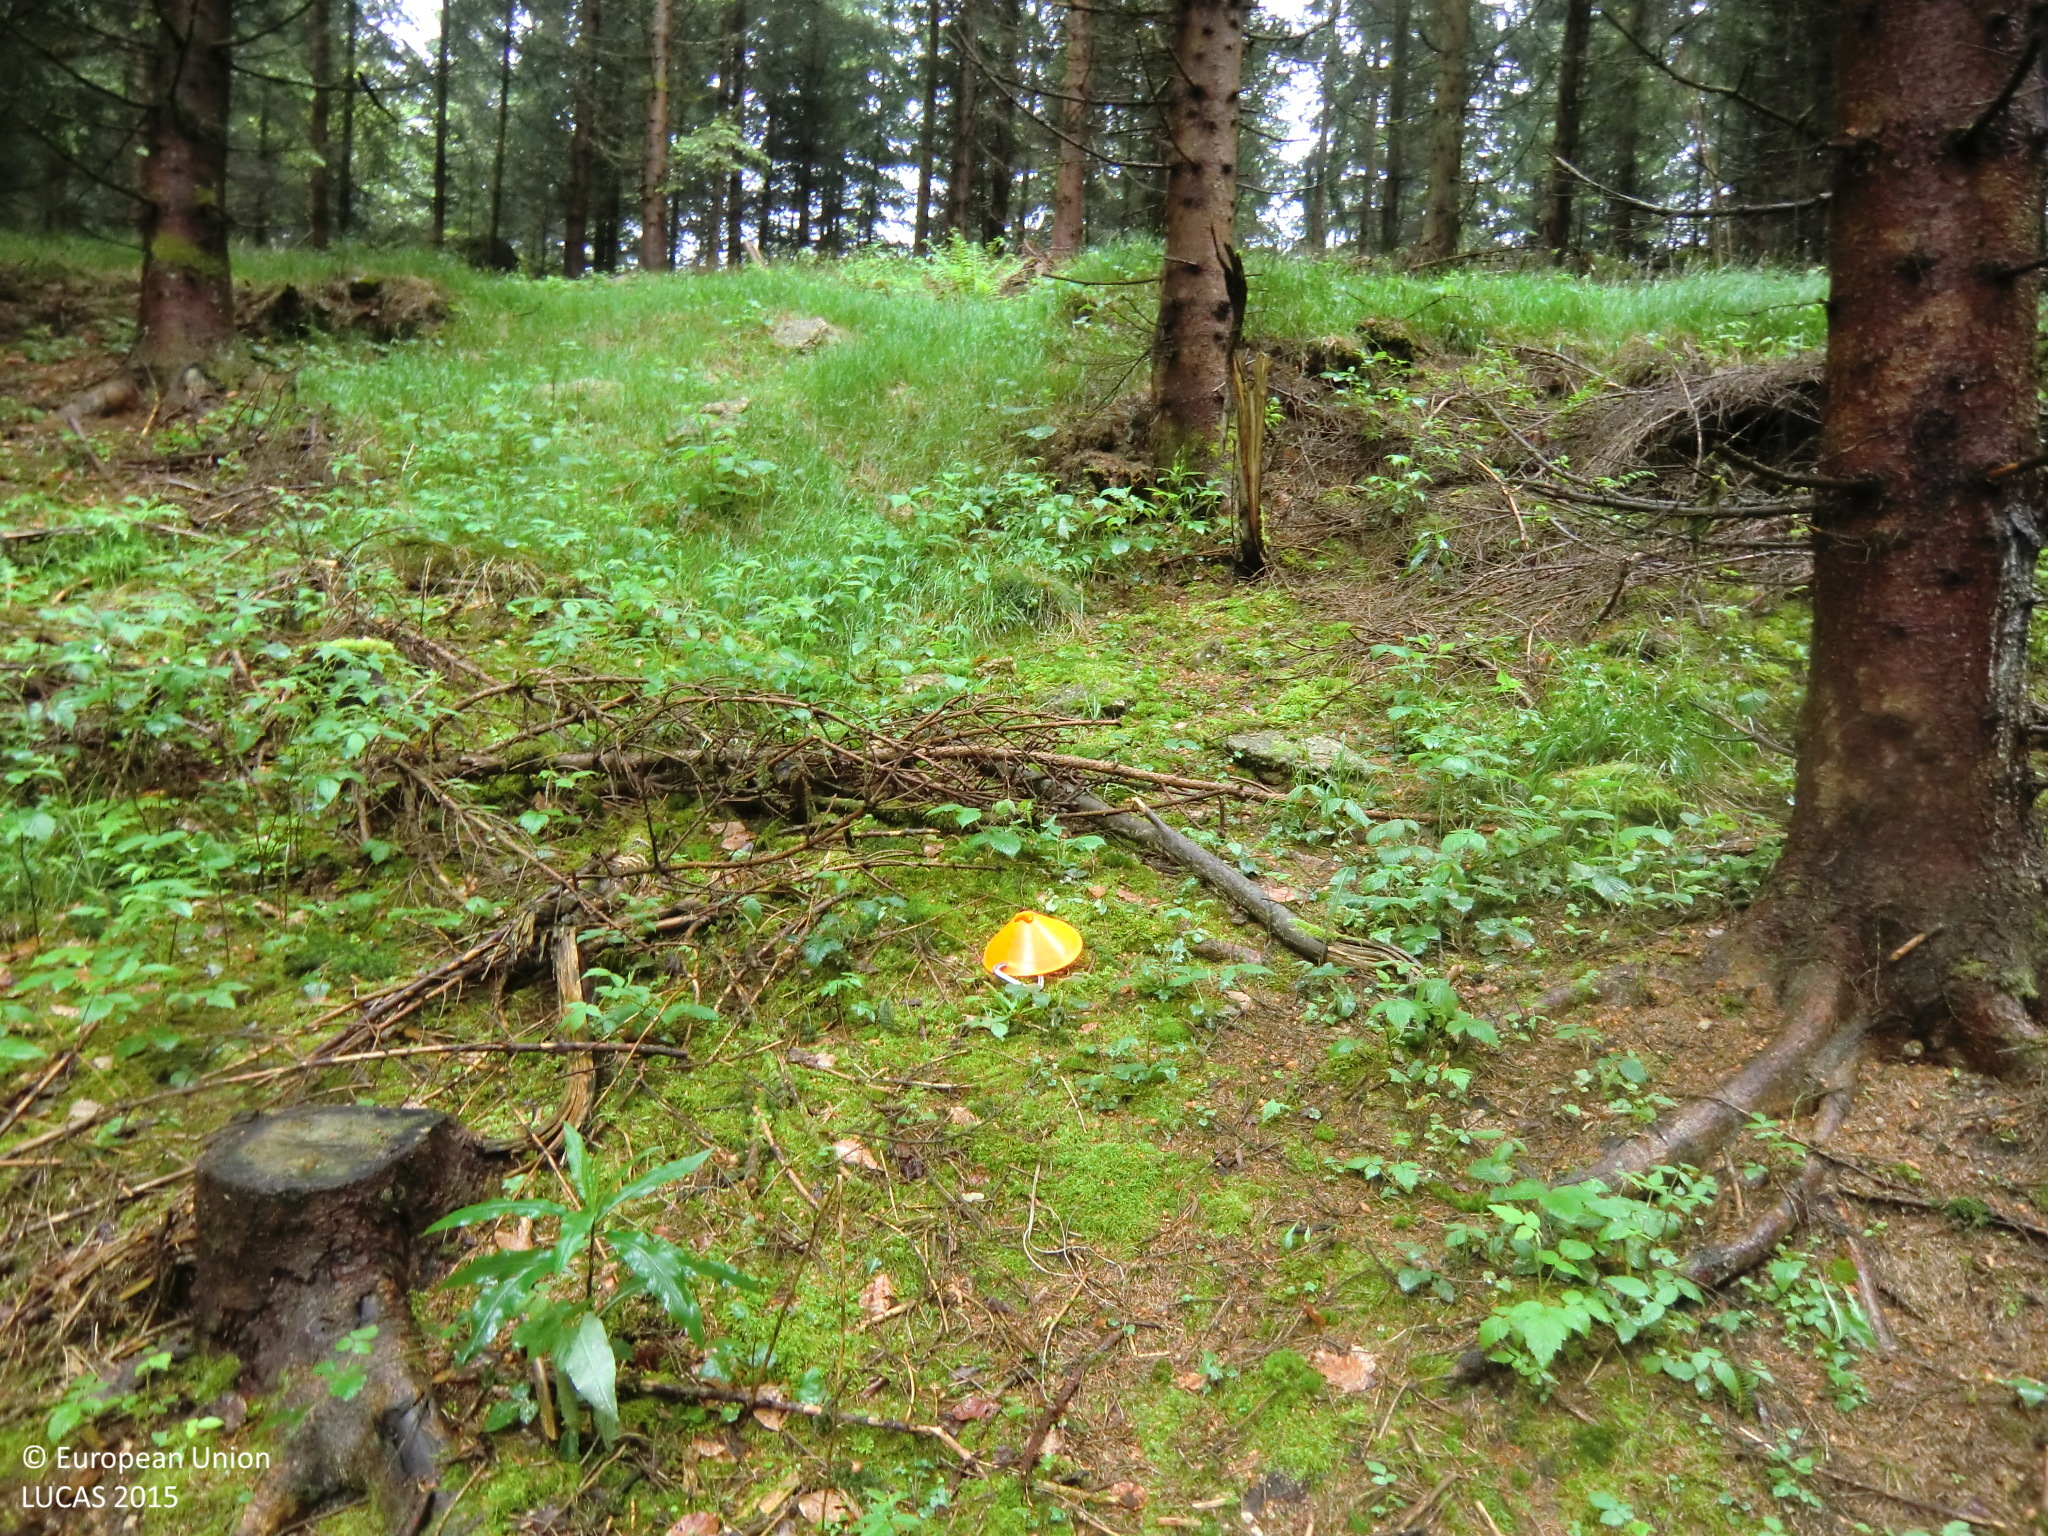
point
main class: Woodland
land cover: Spruce dominated coniferous woodland
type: hemiboreal forest and nemoral coniferous forest and mixed broadleaved-coniferous forest
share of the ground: > 75 %
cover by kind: coniferous forest trees 75 %, herbaceous plants 10 %, lichens and mosses 10 %, unconsolidated bare surface 5 %
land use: Forestry
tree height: > 5 m
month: May
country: AT
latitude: 48.3728
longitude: 14.7665
